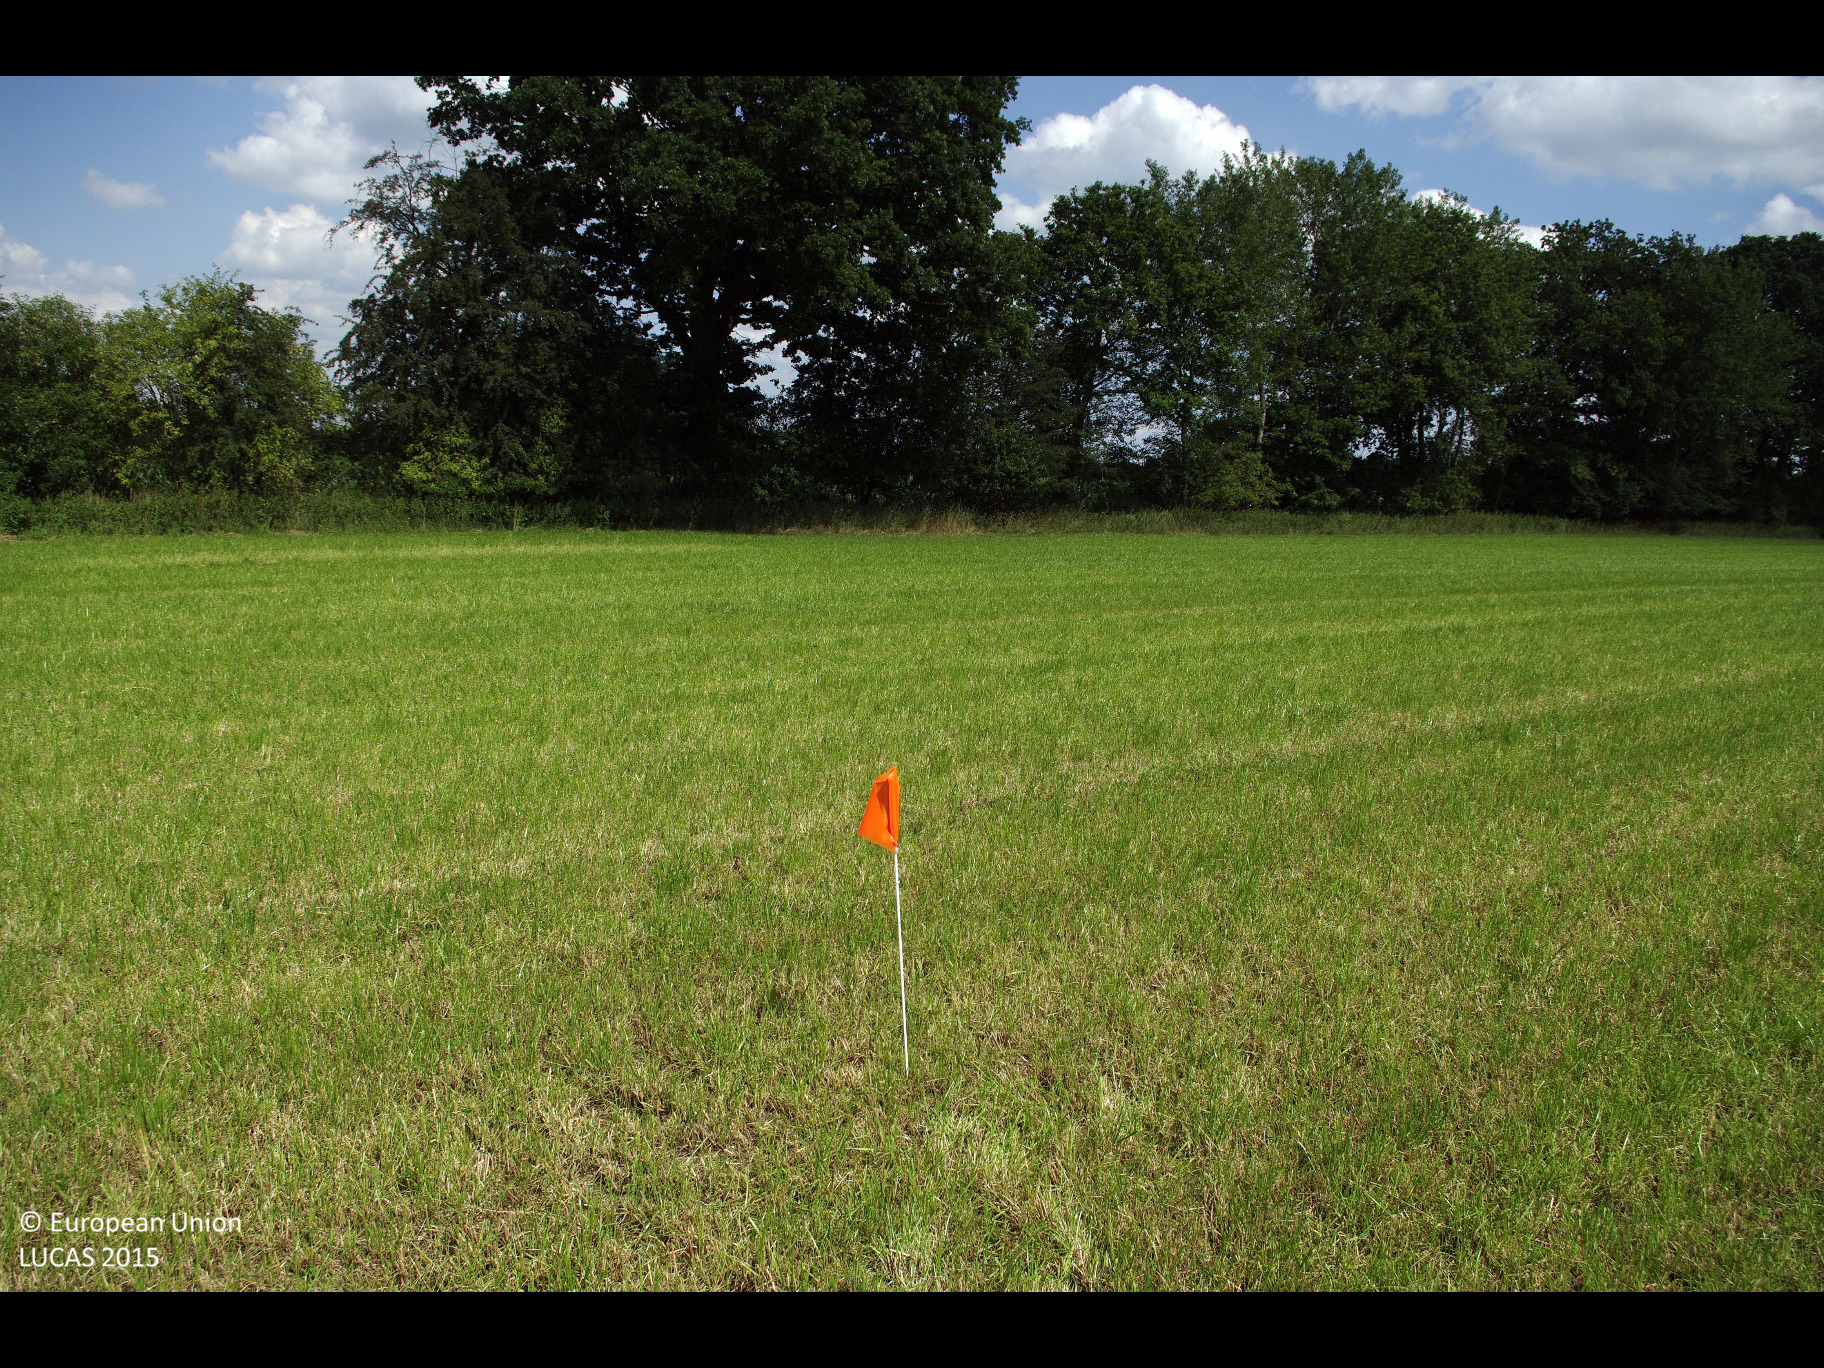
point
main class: Cropland
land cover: Temporary grasslands
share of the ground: > 75 %
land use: Agriculture (excluding fallow land and kitchen gardens)
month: July
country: DE
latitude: 53.8871
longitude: 9.8936
